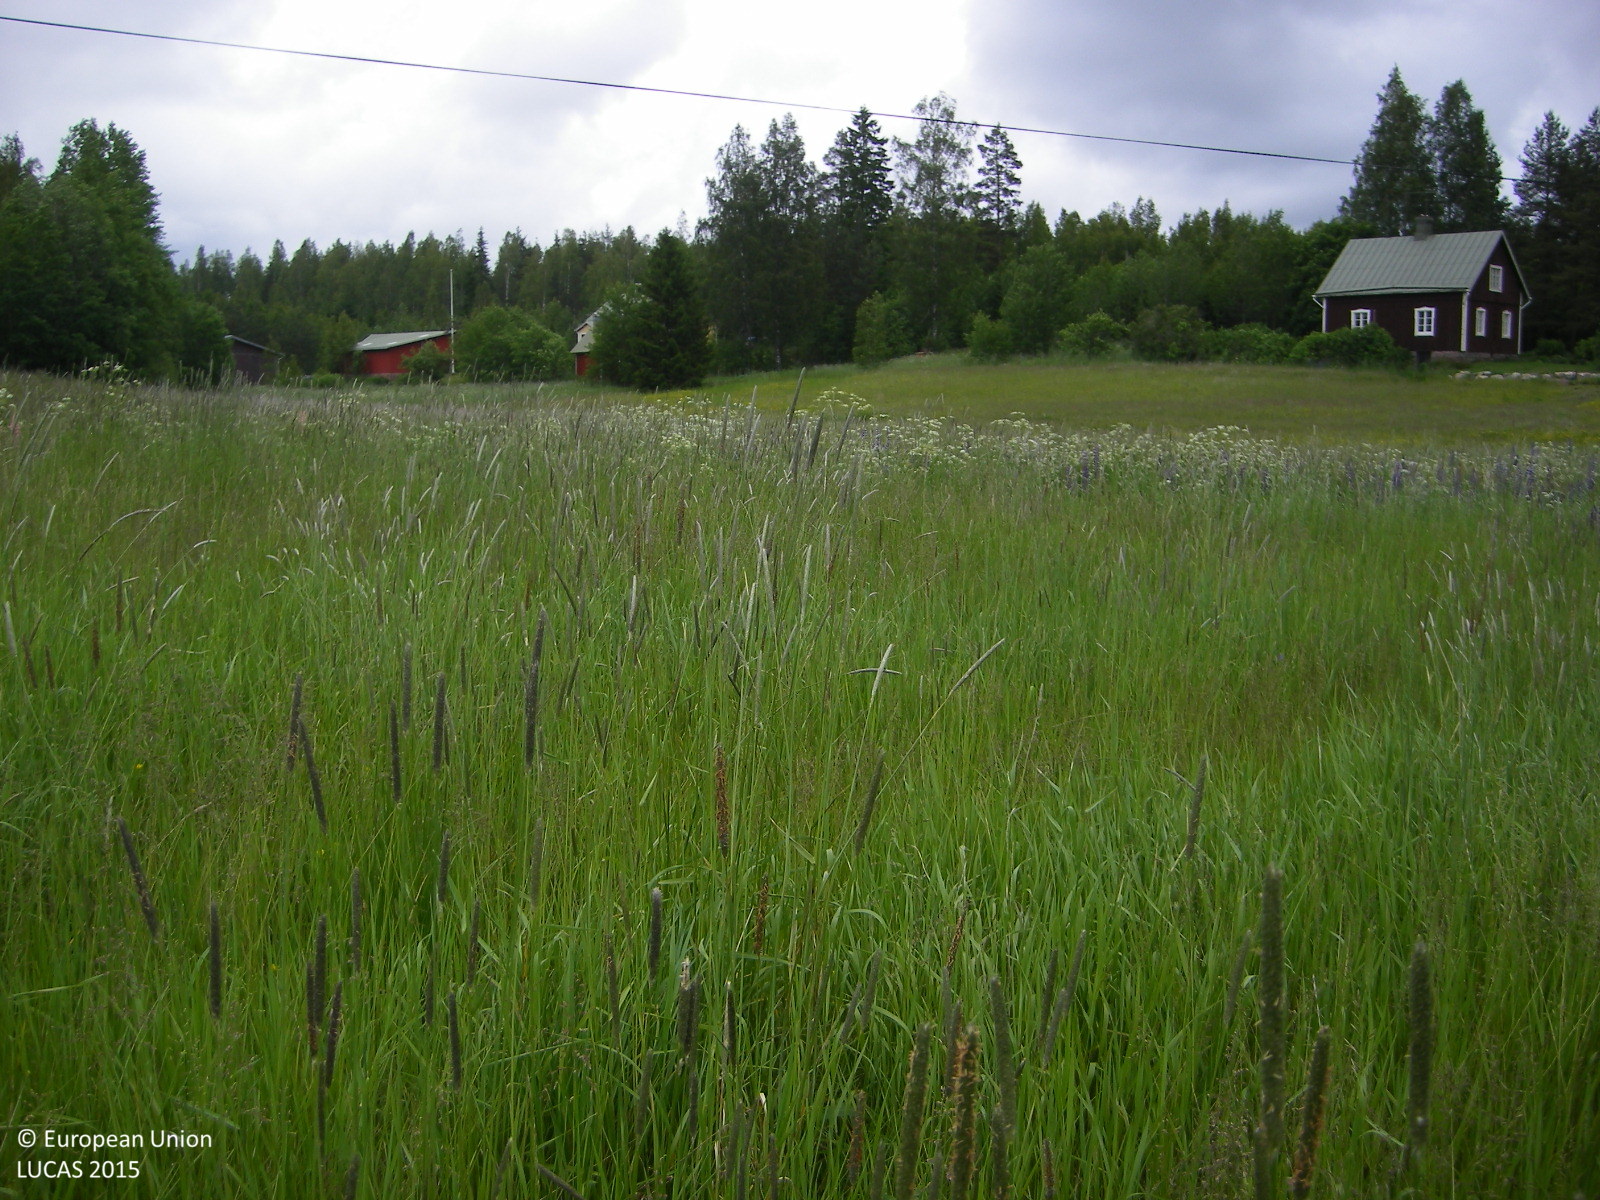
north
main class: Grassland
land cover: Grassland without tree/shrub cover
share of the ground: > 75 %
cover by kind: herbaceous plants 100 %
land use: Agriculture (excluding fallow land and kitchen gardens)
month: June
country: FI
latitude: 60.2081
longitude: 23.2745
